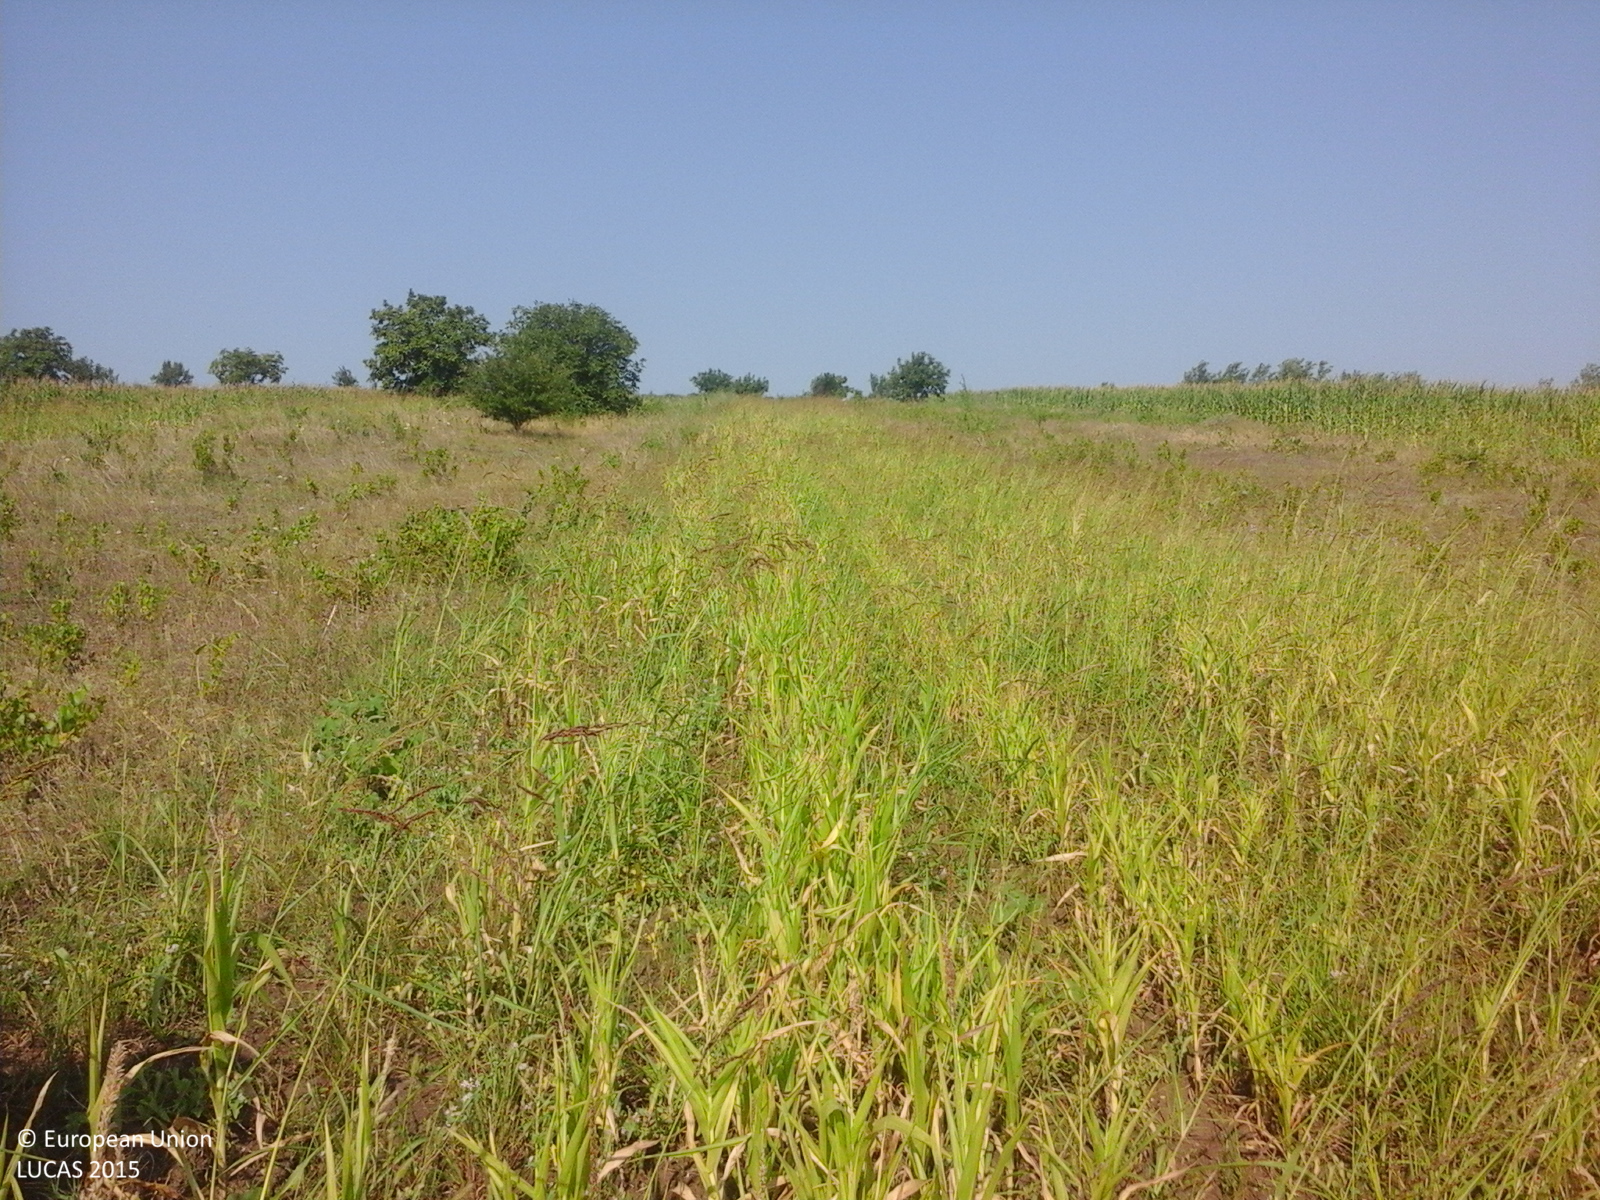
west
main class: Cropland
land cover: Maize
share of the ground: 50 - 75 %
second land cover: Spontaneously vegetated surfaces
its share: 25 - 50 %
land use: Agriculture (excluding fallow land and kitchen gardens)
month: July
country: RO
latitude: 45.7479
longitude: 27.8939
